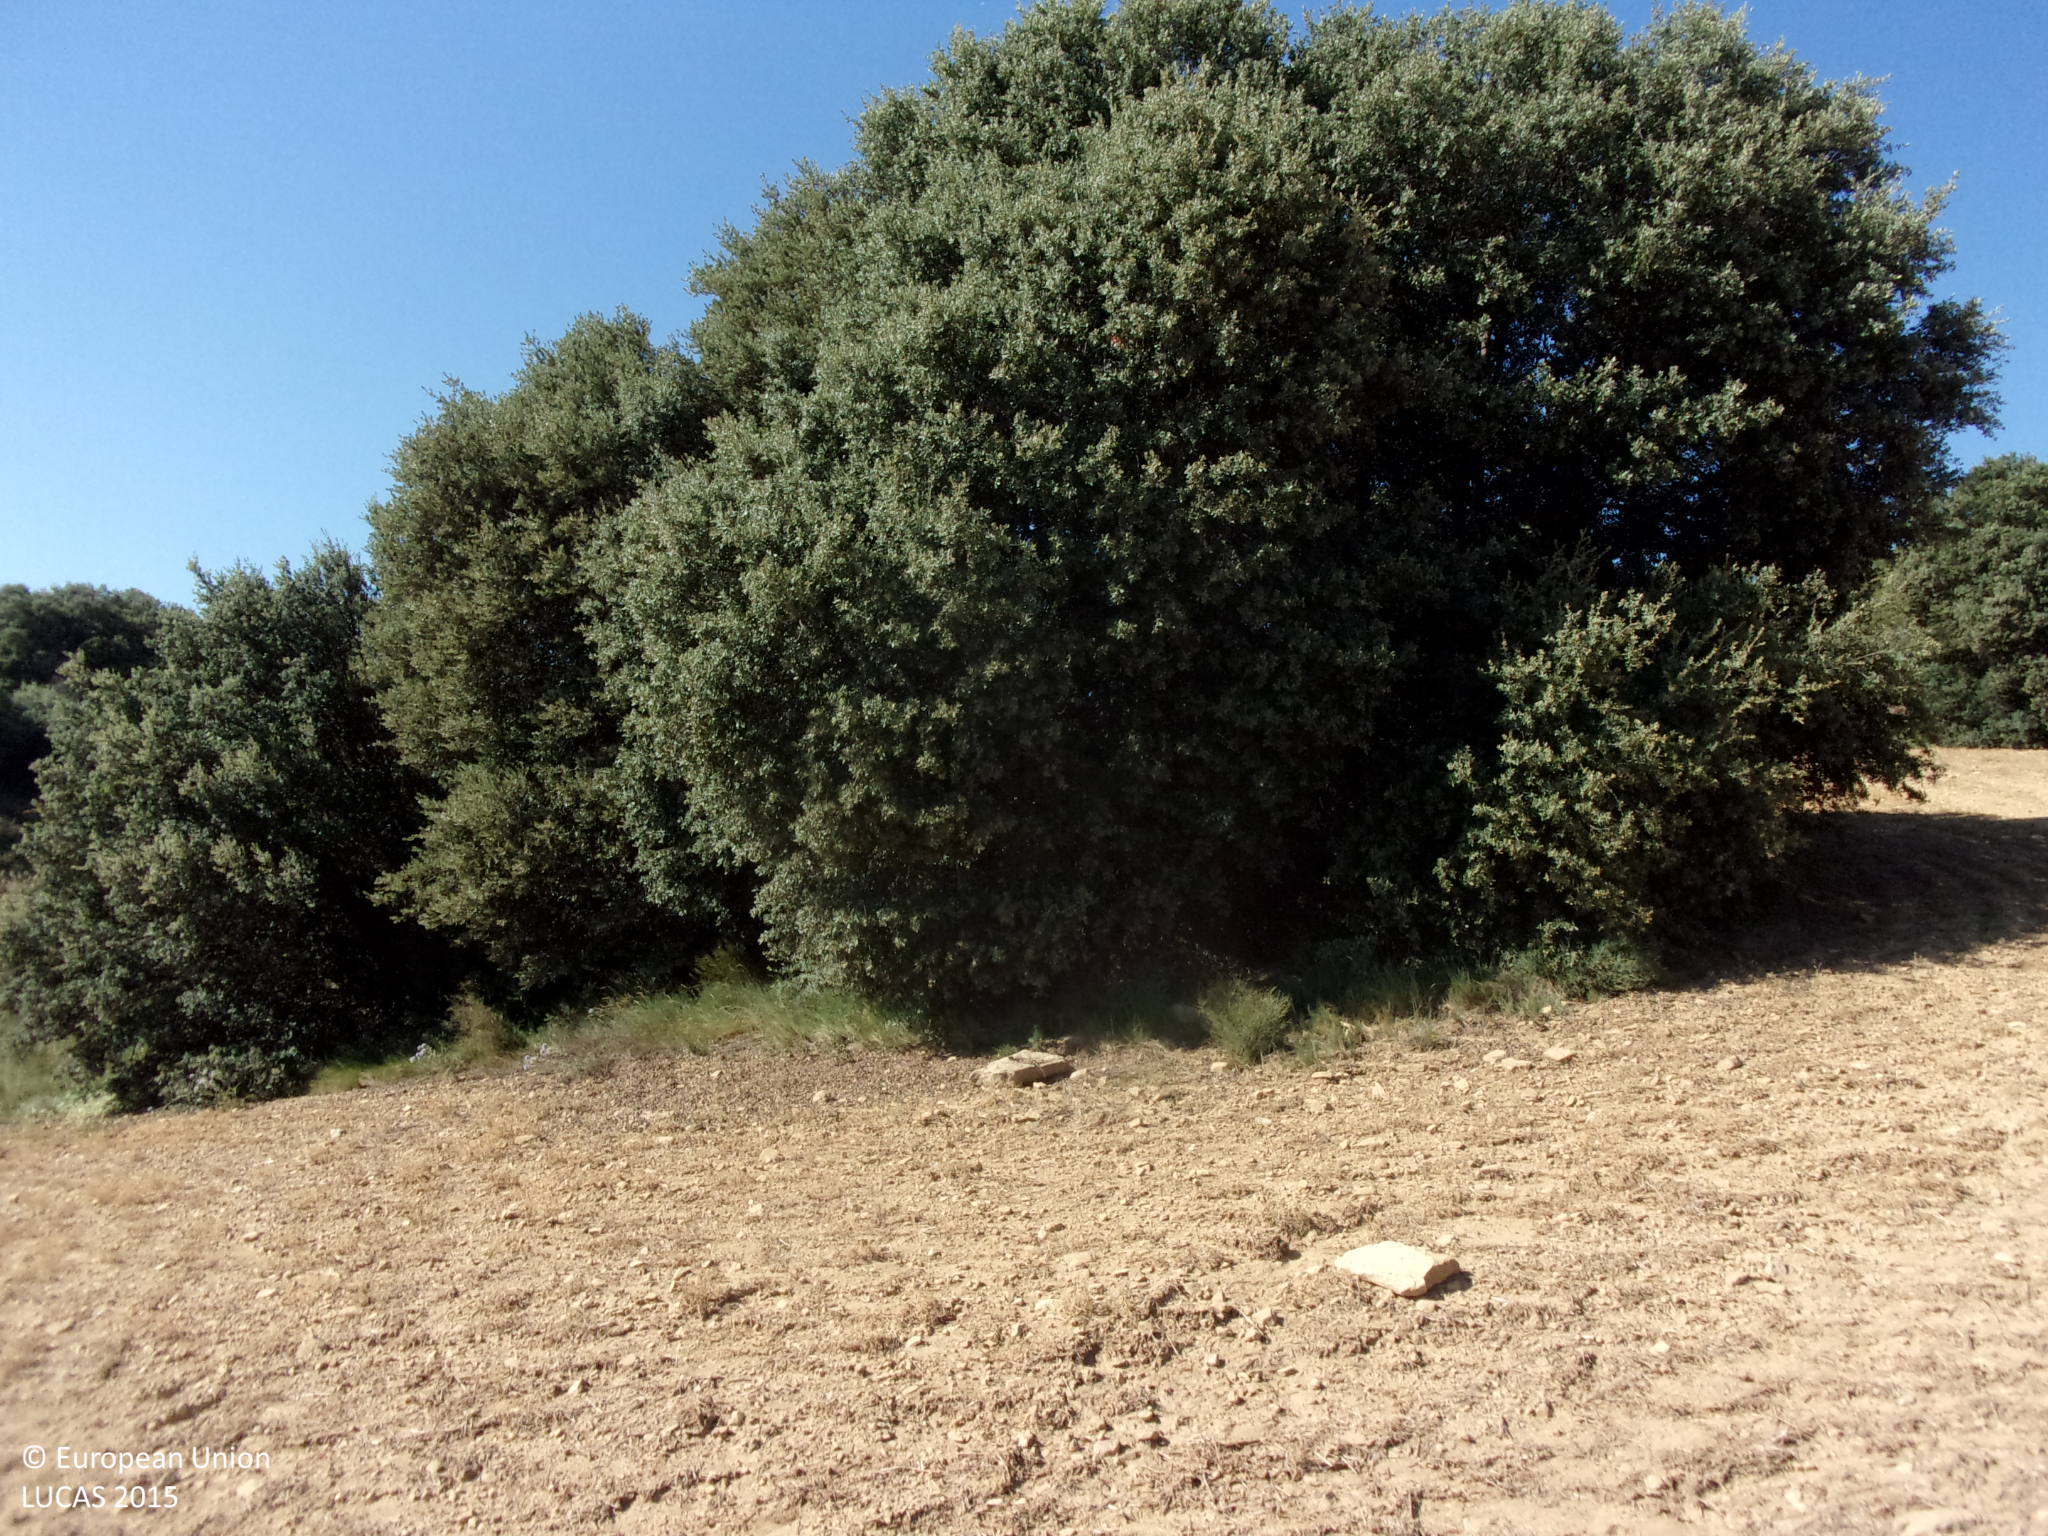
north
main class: Grassland
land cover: Spontaneously vegetated surfaces
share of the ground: 50 - 75 %
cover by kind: herbaceous plants 75 %, unconsolidated bare surface 25 %
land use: Fallow land
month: August
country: ES
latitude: 42.3349
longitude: -1.0861
